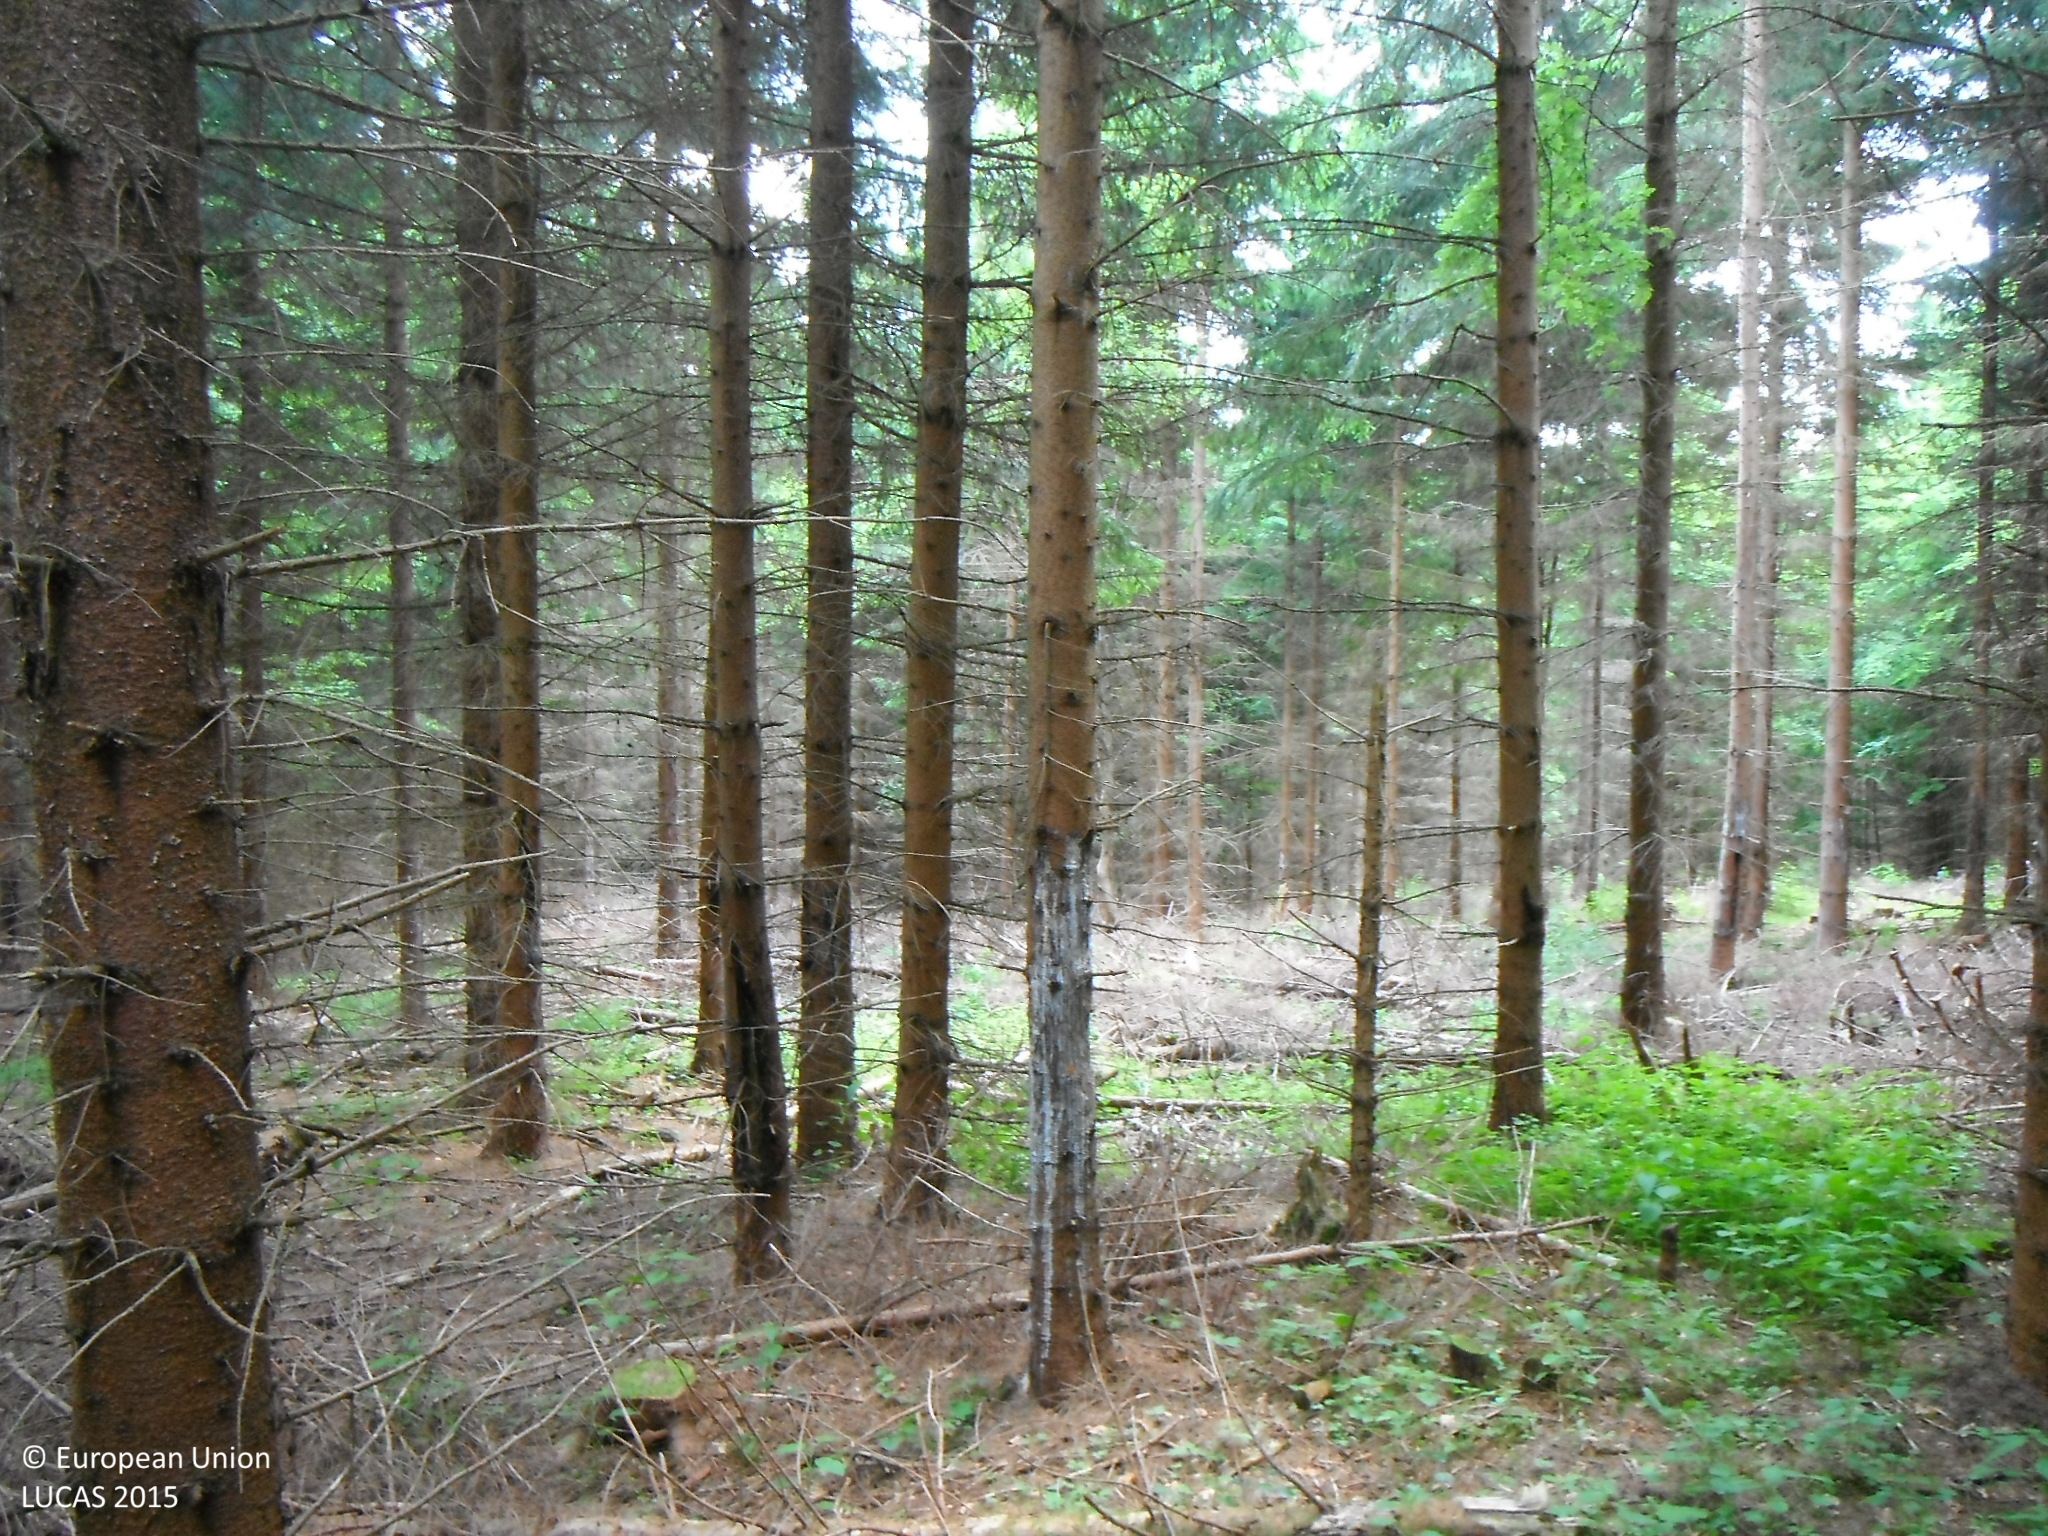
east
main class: Woodland
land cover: Spruce dominated coniferous woodland
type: alpine coniferous forest
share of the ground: > 75 %
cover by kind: coniferous forest trees 100 %
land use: Forestry
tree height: > 5 m
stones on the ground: < 10 %
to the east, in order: Spruce dominated coniferous woodland
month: June
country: SK
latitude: 48.7206
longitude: 18.8142
